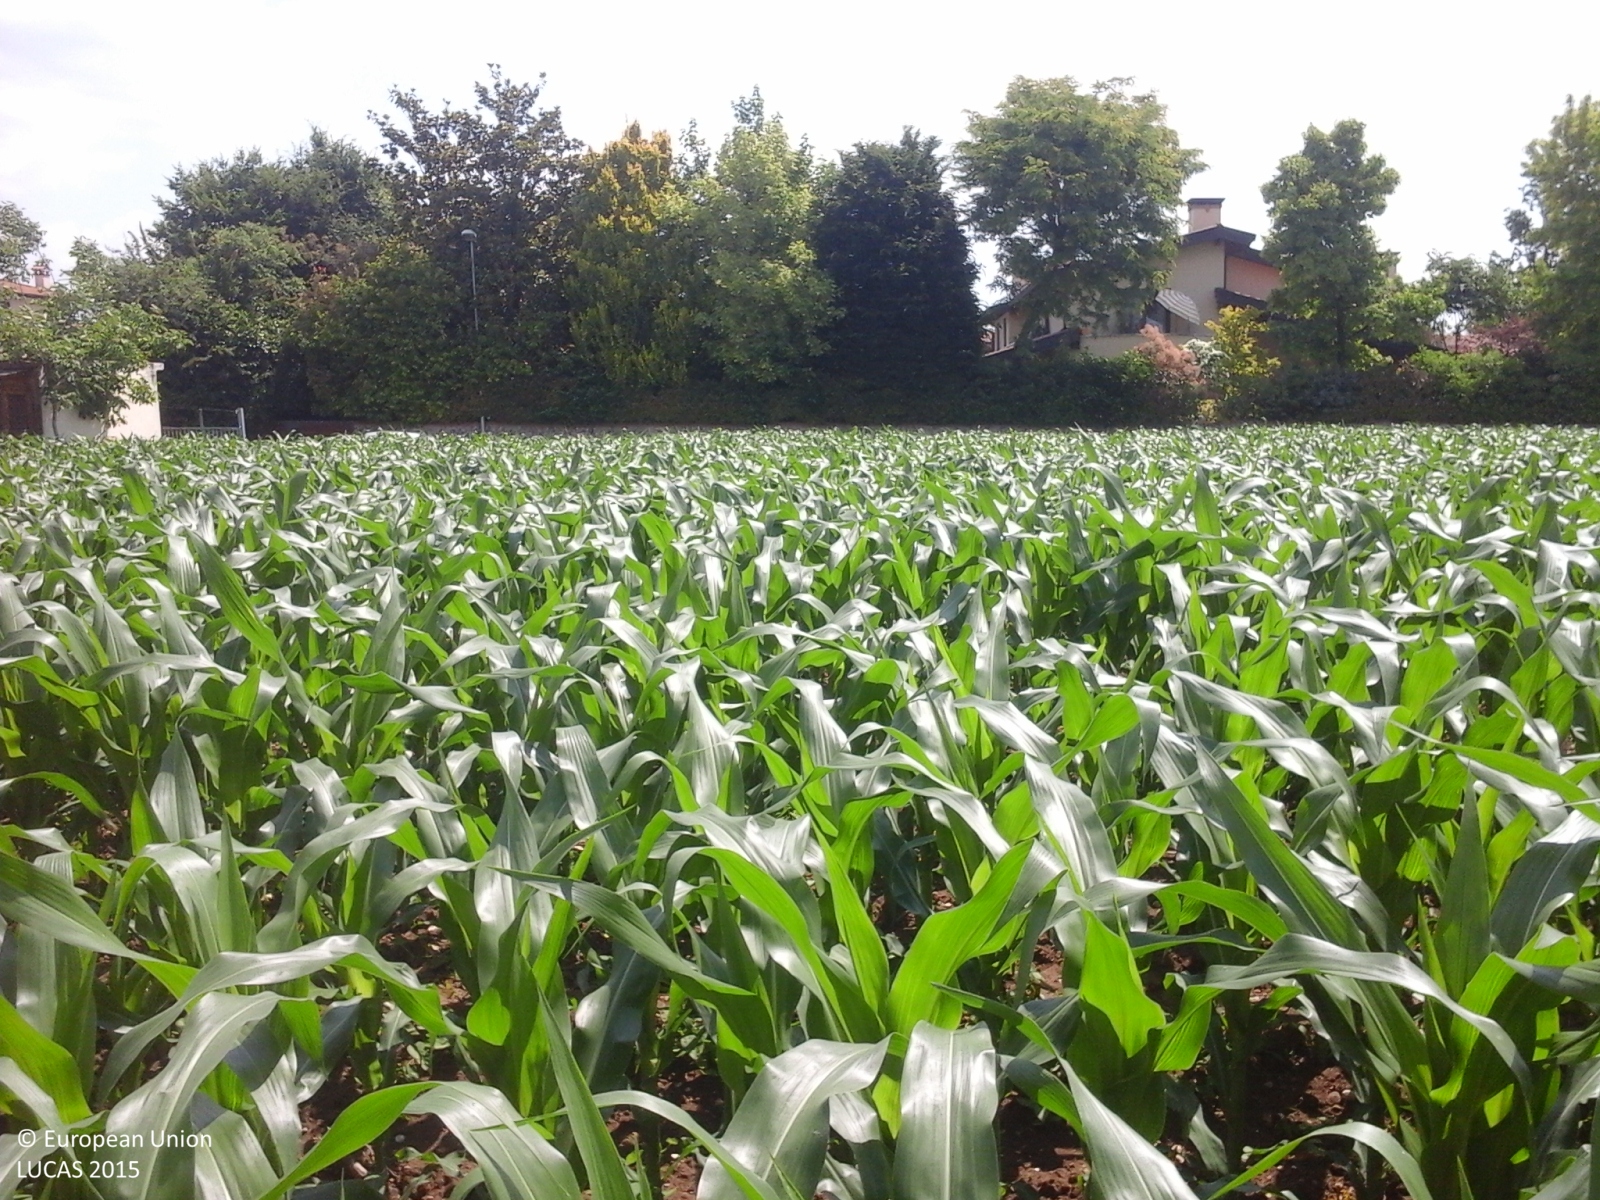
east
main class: Cropland
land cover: Maize
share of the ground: > 75 %
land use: Agriculture (excluding fallow land and kitchen gardens)
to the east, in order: Maize; Artificial constructions in urban areas; Managed hedges; Maize
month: May
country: IT
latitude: 45.6545
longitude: 11.6016
